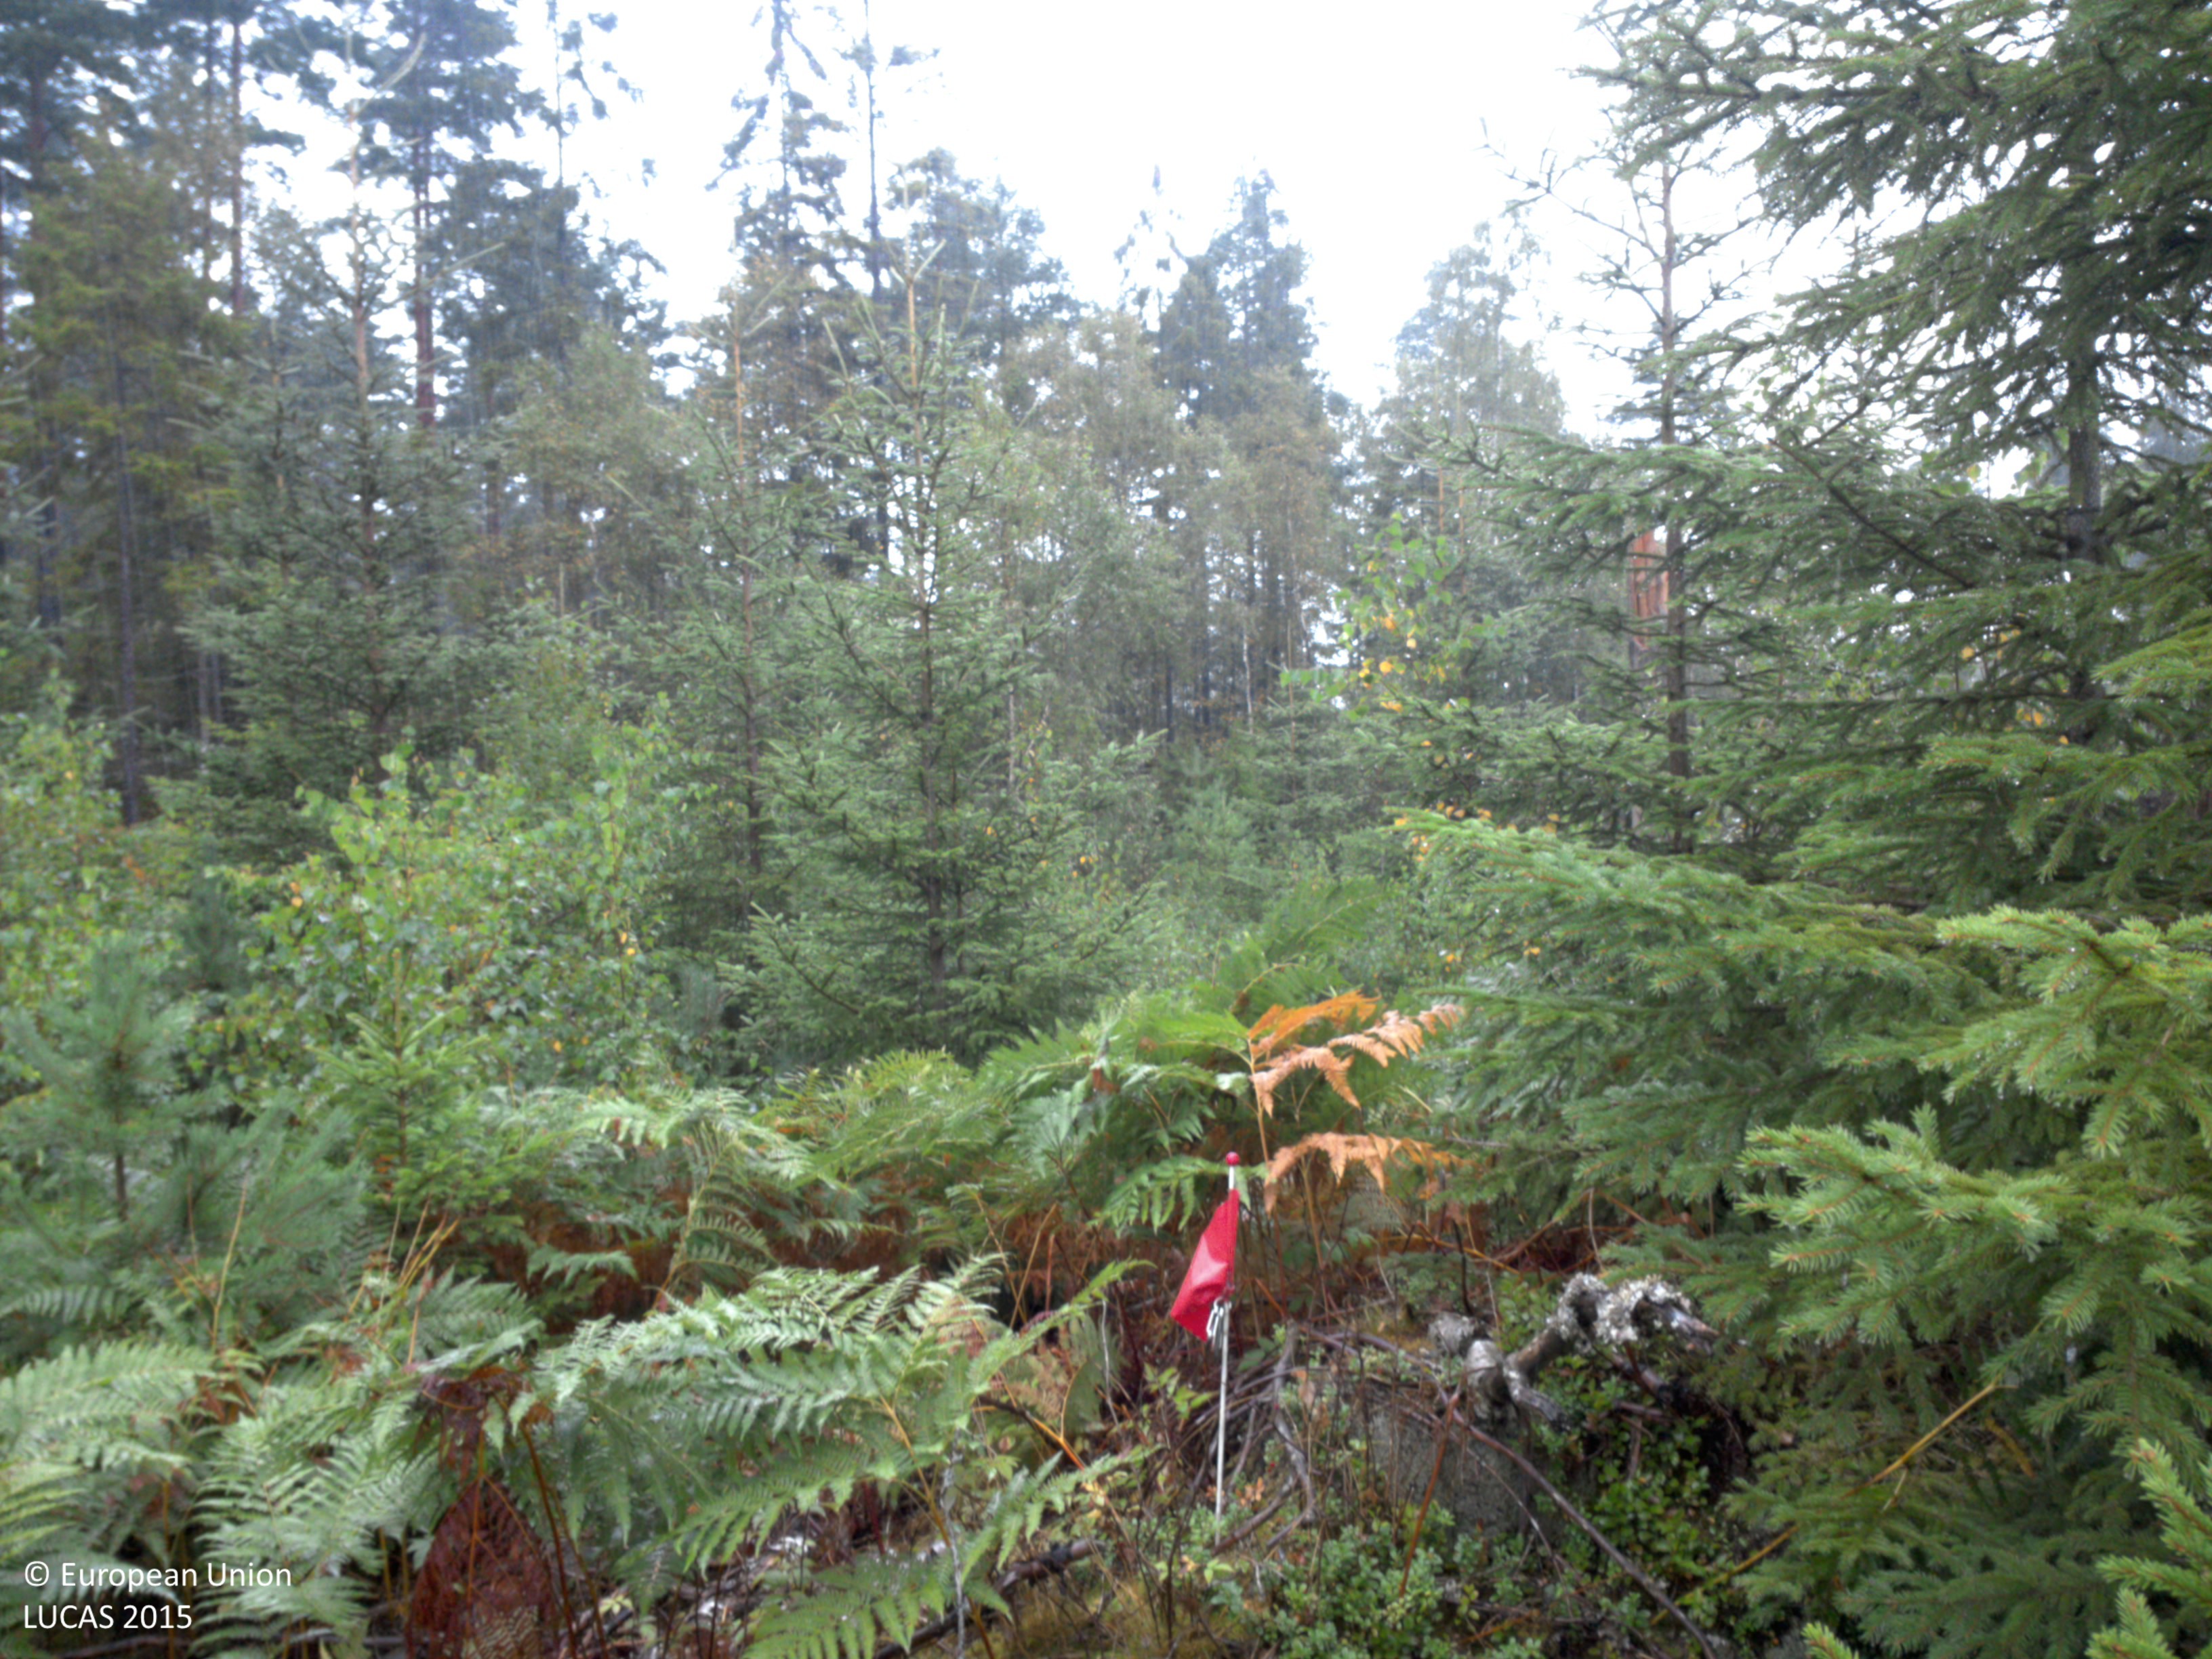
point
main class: Woodland
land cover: Spruce dominated mixed woodland
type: boreal forest
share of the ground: 50 - 75 %
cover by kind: coniferous forest trees 50 %, broadleaved forest trees 20 %, shrubs 15 %, herbaceous plants 10 %, lichens and mosses 5 %
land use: Forestry
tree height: < 5 m
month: August
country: SE
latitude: 58.0735
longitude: 12.3185
